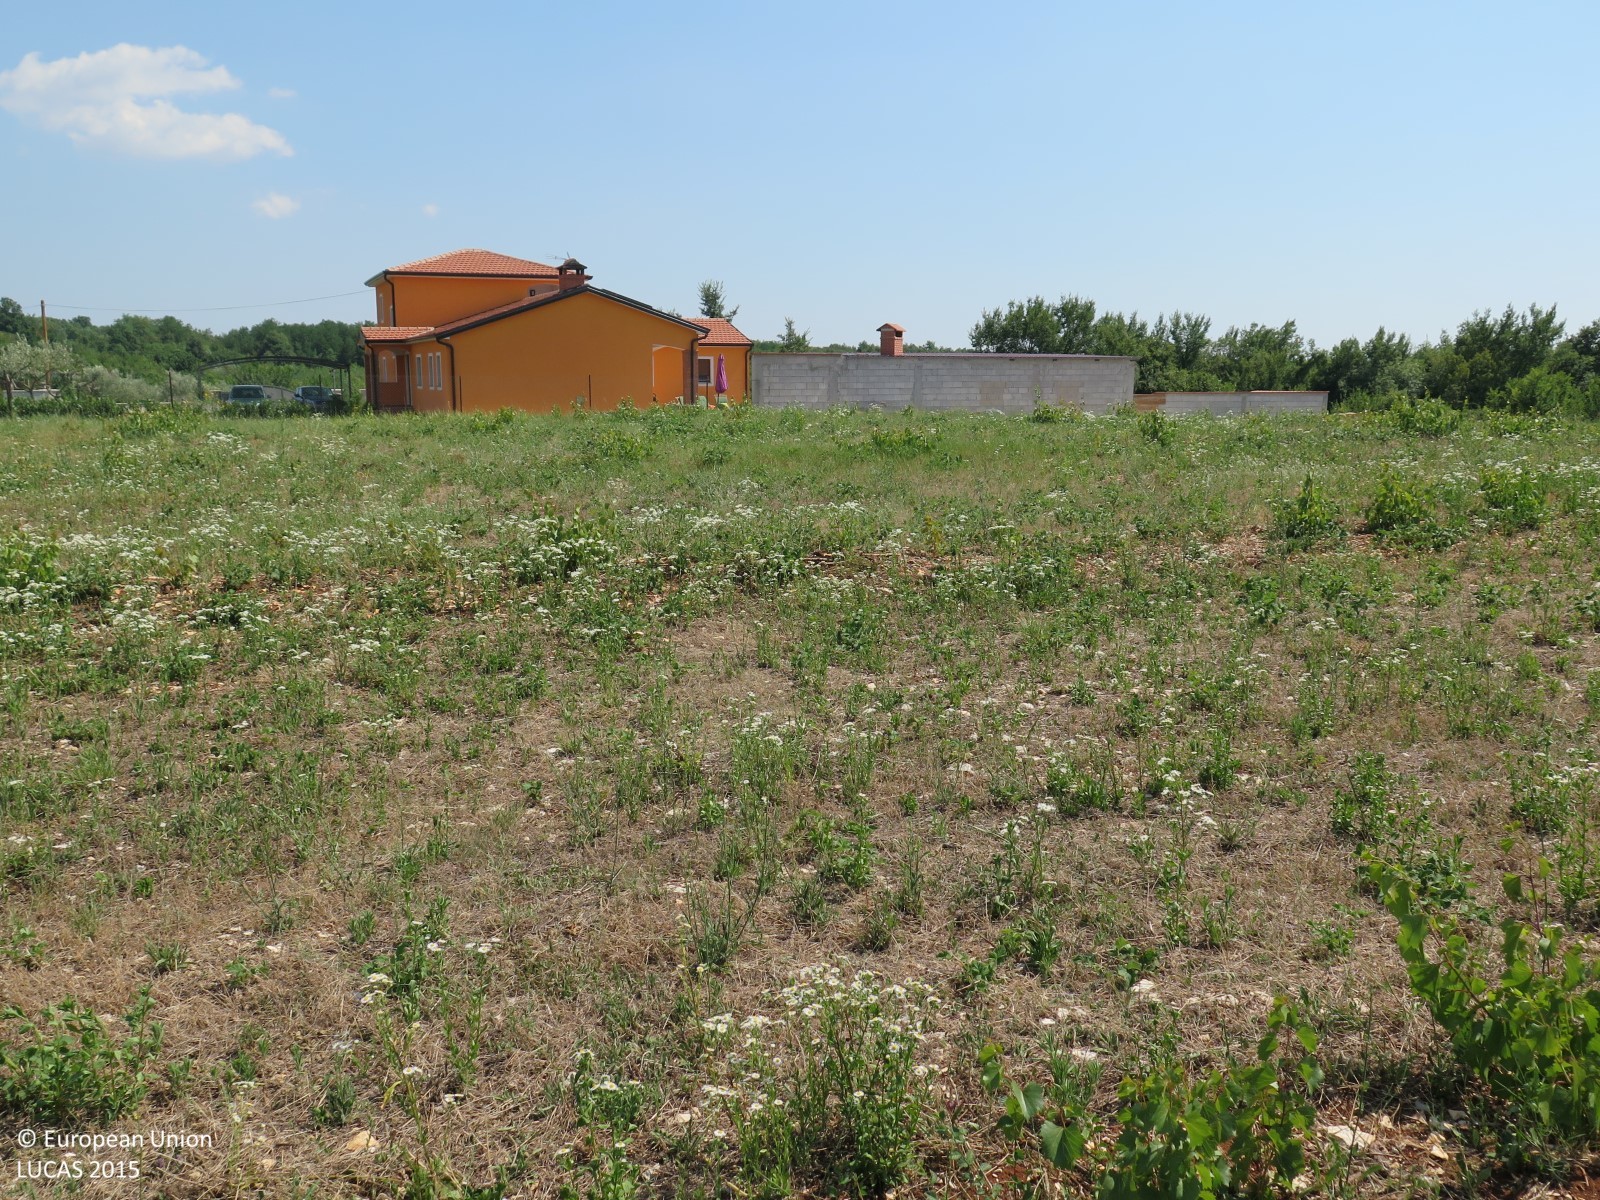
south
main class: Grassland
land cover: Grassland without tree/shrub cover
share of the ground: > 75 %
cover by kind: herbaceous plants 100 %
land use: Abandoned areas
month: July
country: HR
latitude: 45.1654
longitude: 13.7987
